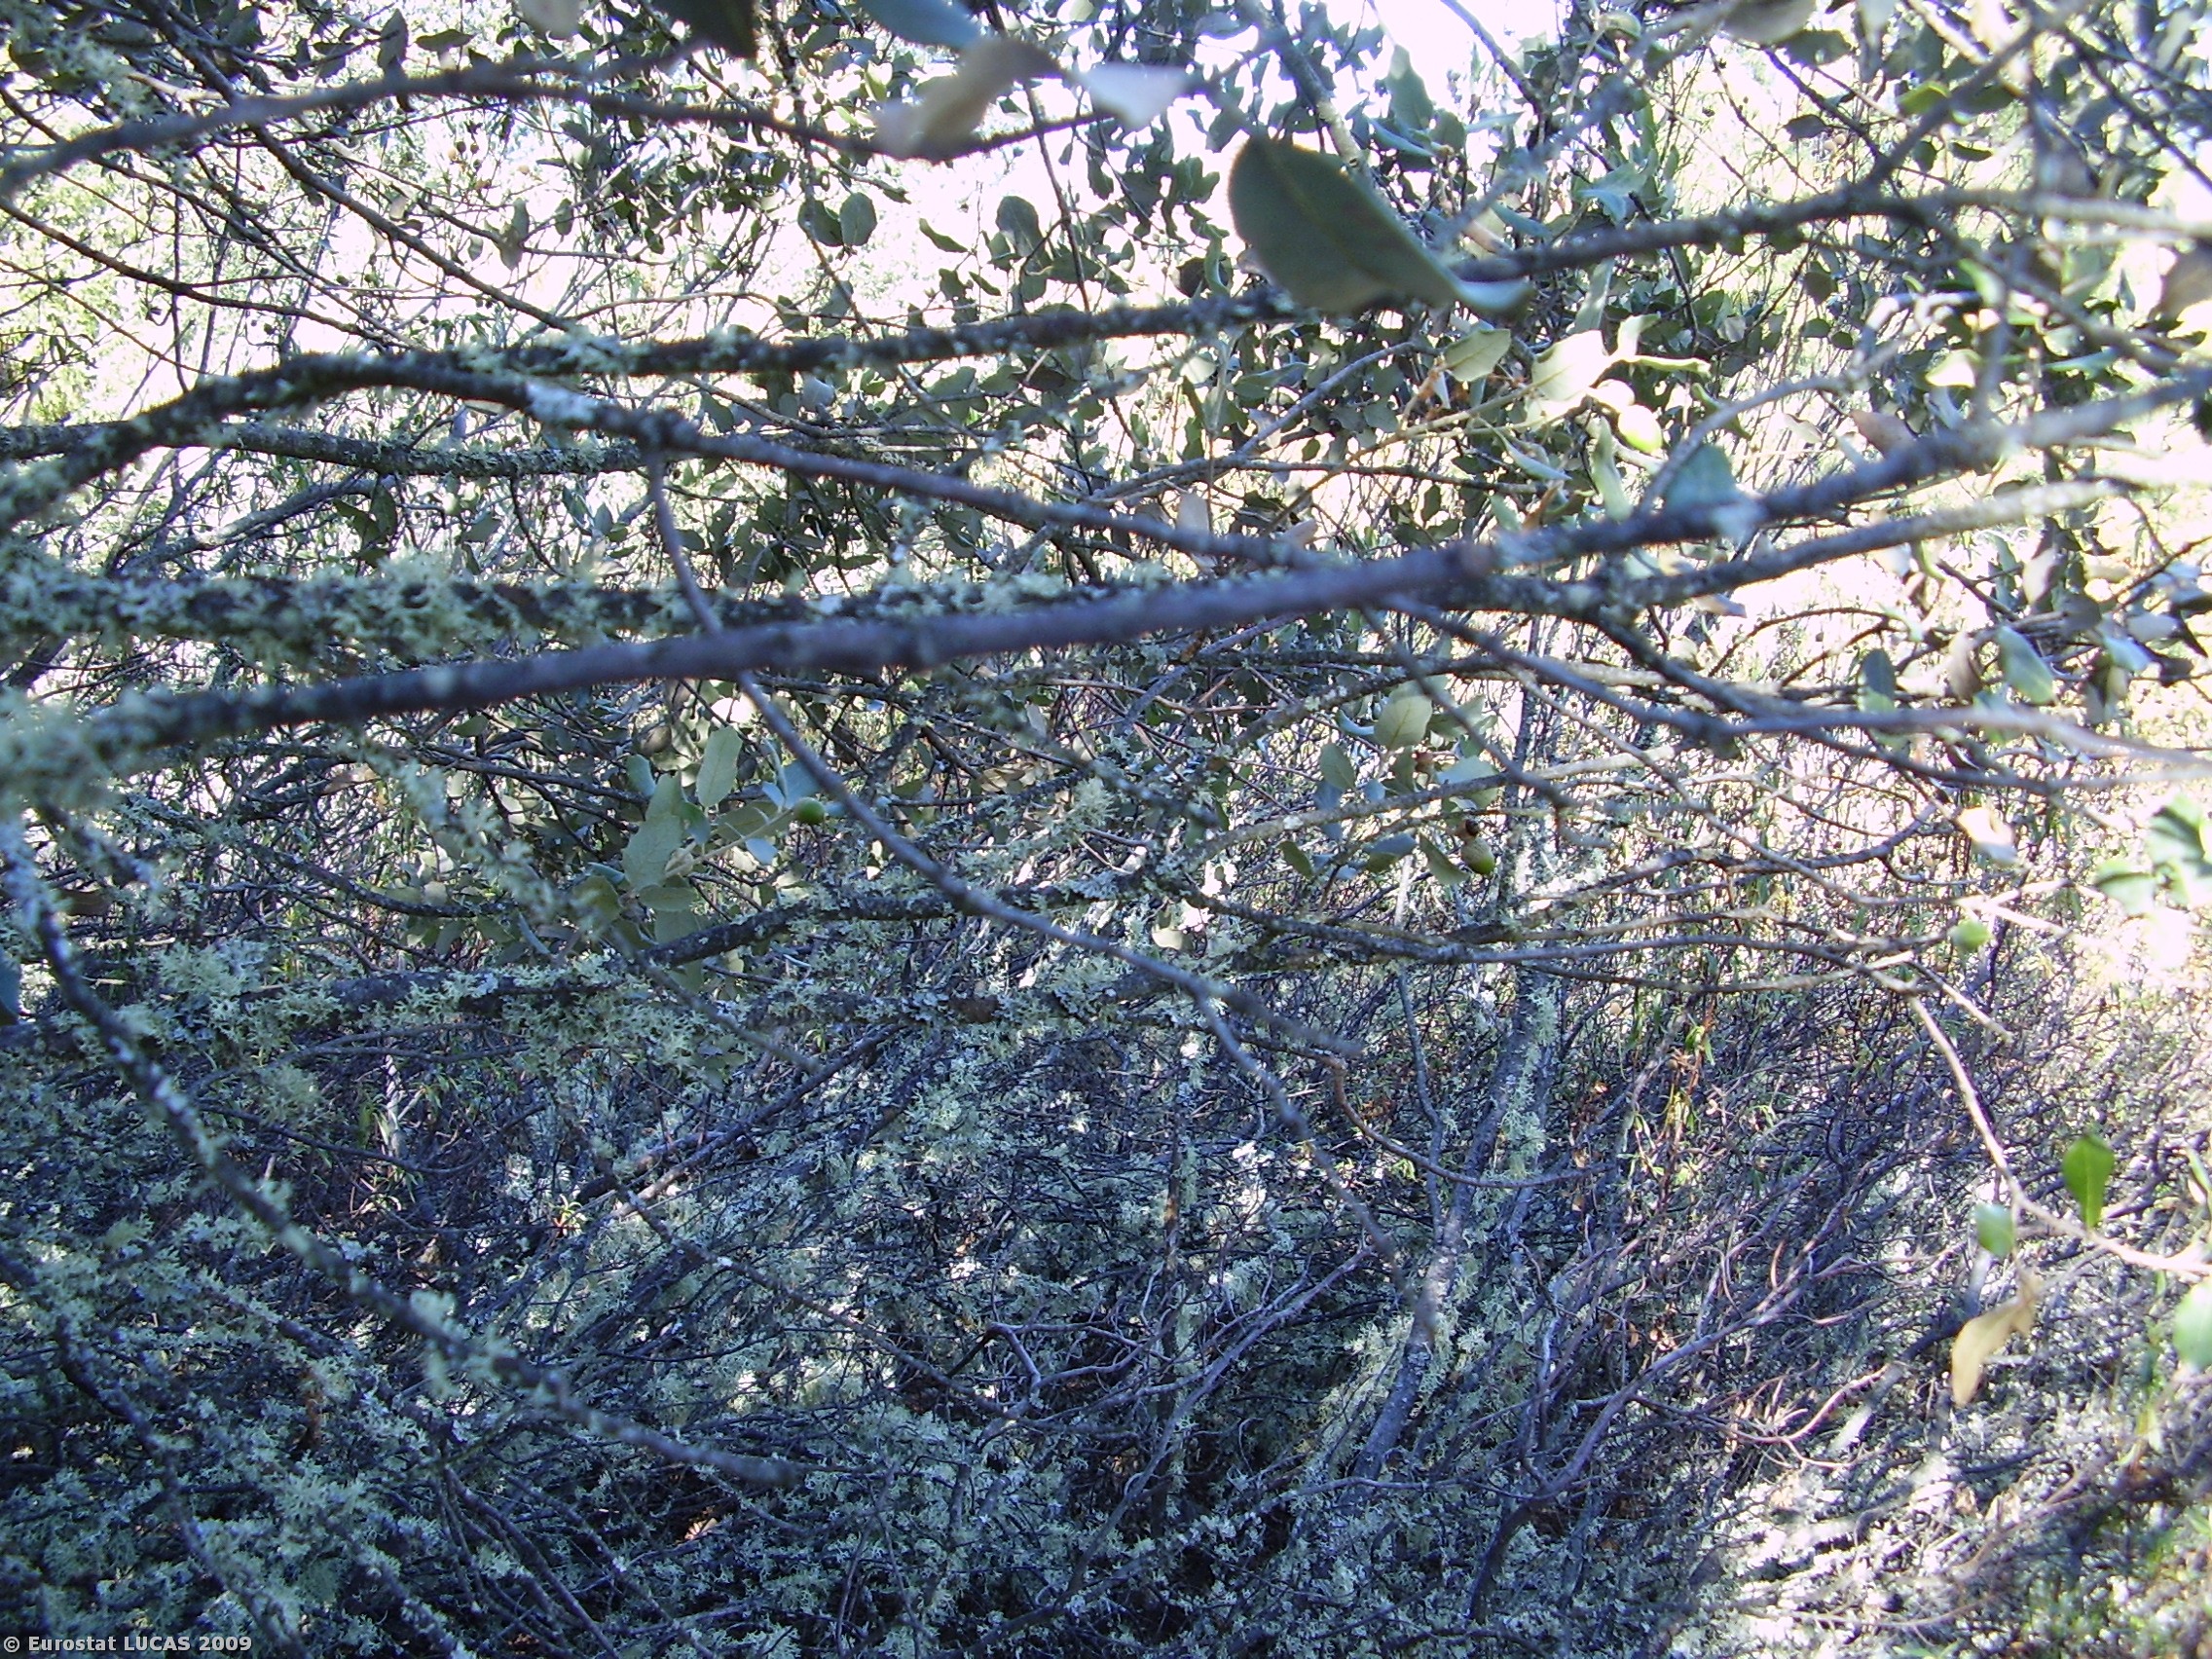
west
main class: Woodland
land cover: Broadleaved woodland
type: broadleaved evergreen forest
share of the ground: 10 - 25 %
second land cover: Shrubland with sparse tree cover
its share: > 75 %
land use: Forestry
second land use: Fallow land
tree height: > 5 m
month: August
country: PT
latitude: 41.3958
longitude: -6.7436
